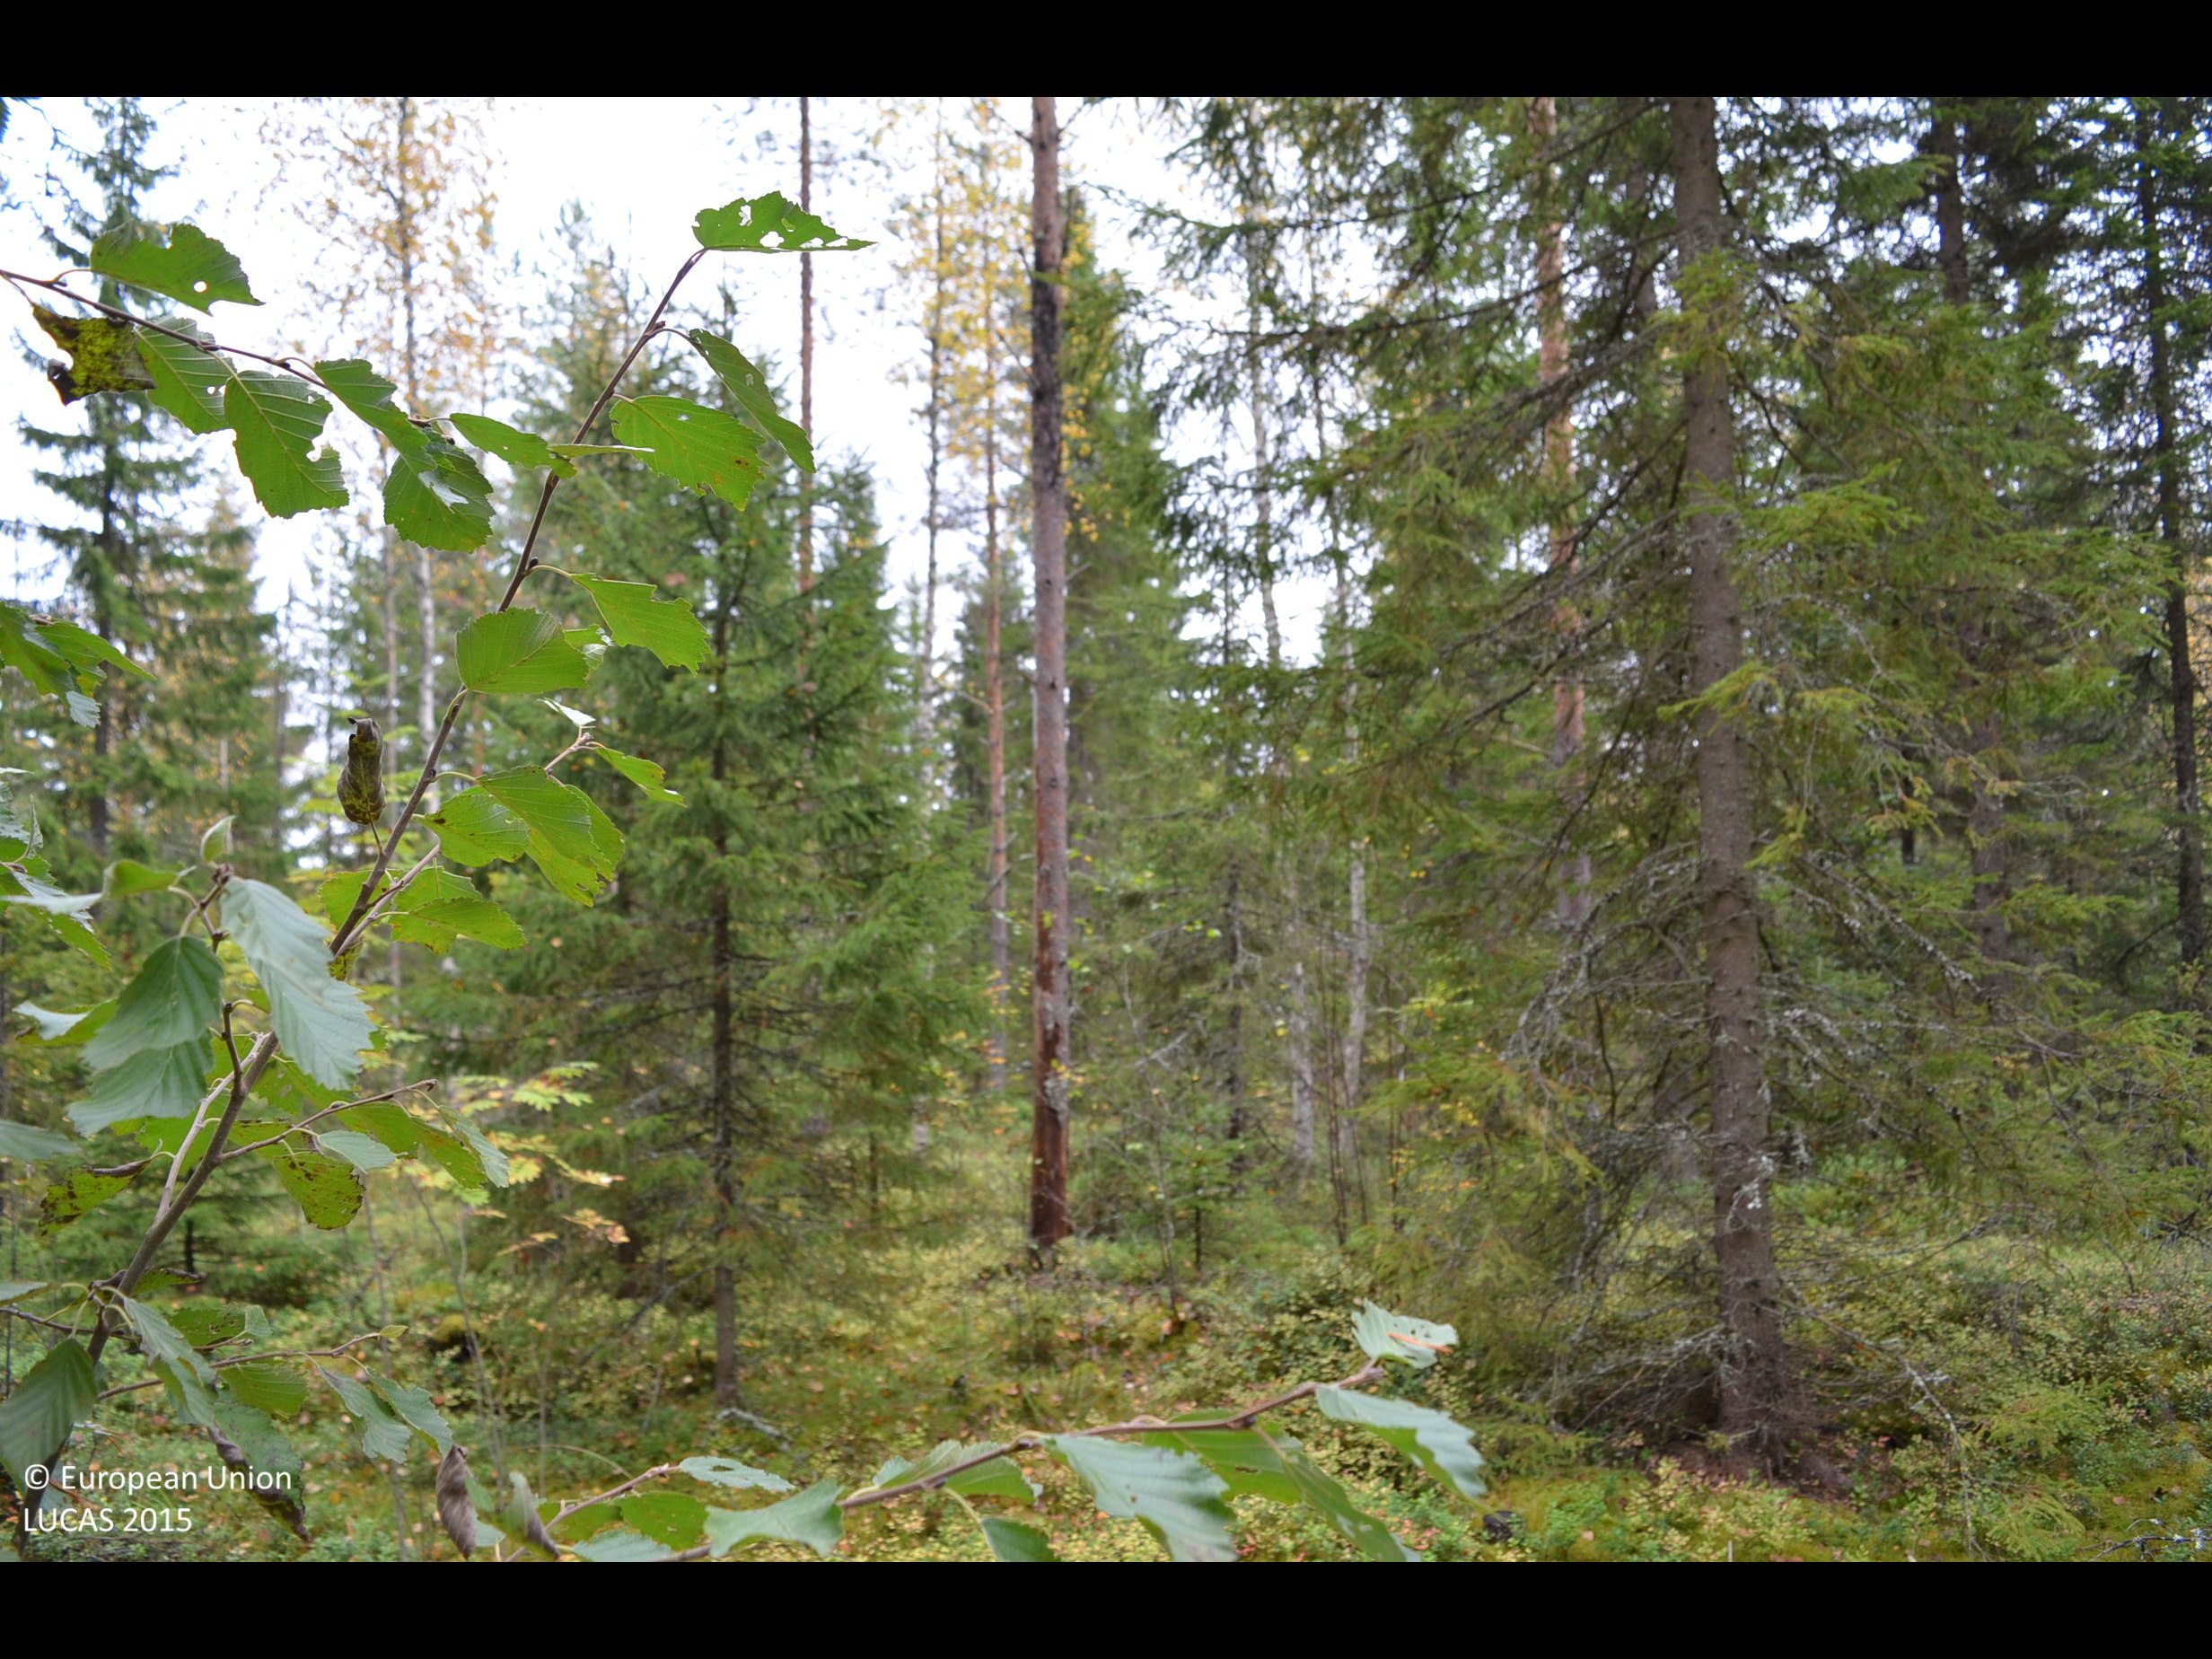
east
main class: Woodland
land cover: Other mixed woodland
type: boreal forest
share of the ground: 50 - 75 %
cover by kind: coniferous forest trees 50 %, broadleaved forest trees 20 %, shrubs 20 %, lichens and mosses 10 %
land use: Forestry
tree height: > 5 m
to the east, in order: Other mixed woodland; Ditches and canals; Other mixed woodland; Shrubland without tree cover; Ditches and canals; Other mixed woodland; Shrubland without tree cover; Ditches and canals; Shrubland without tree cover; Other mixed woodland
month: September
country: FI
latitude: 62.5683
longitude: 23.7136
